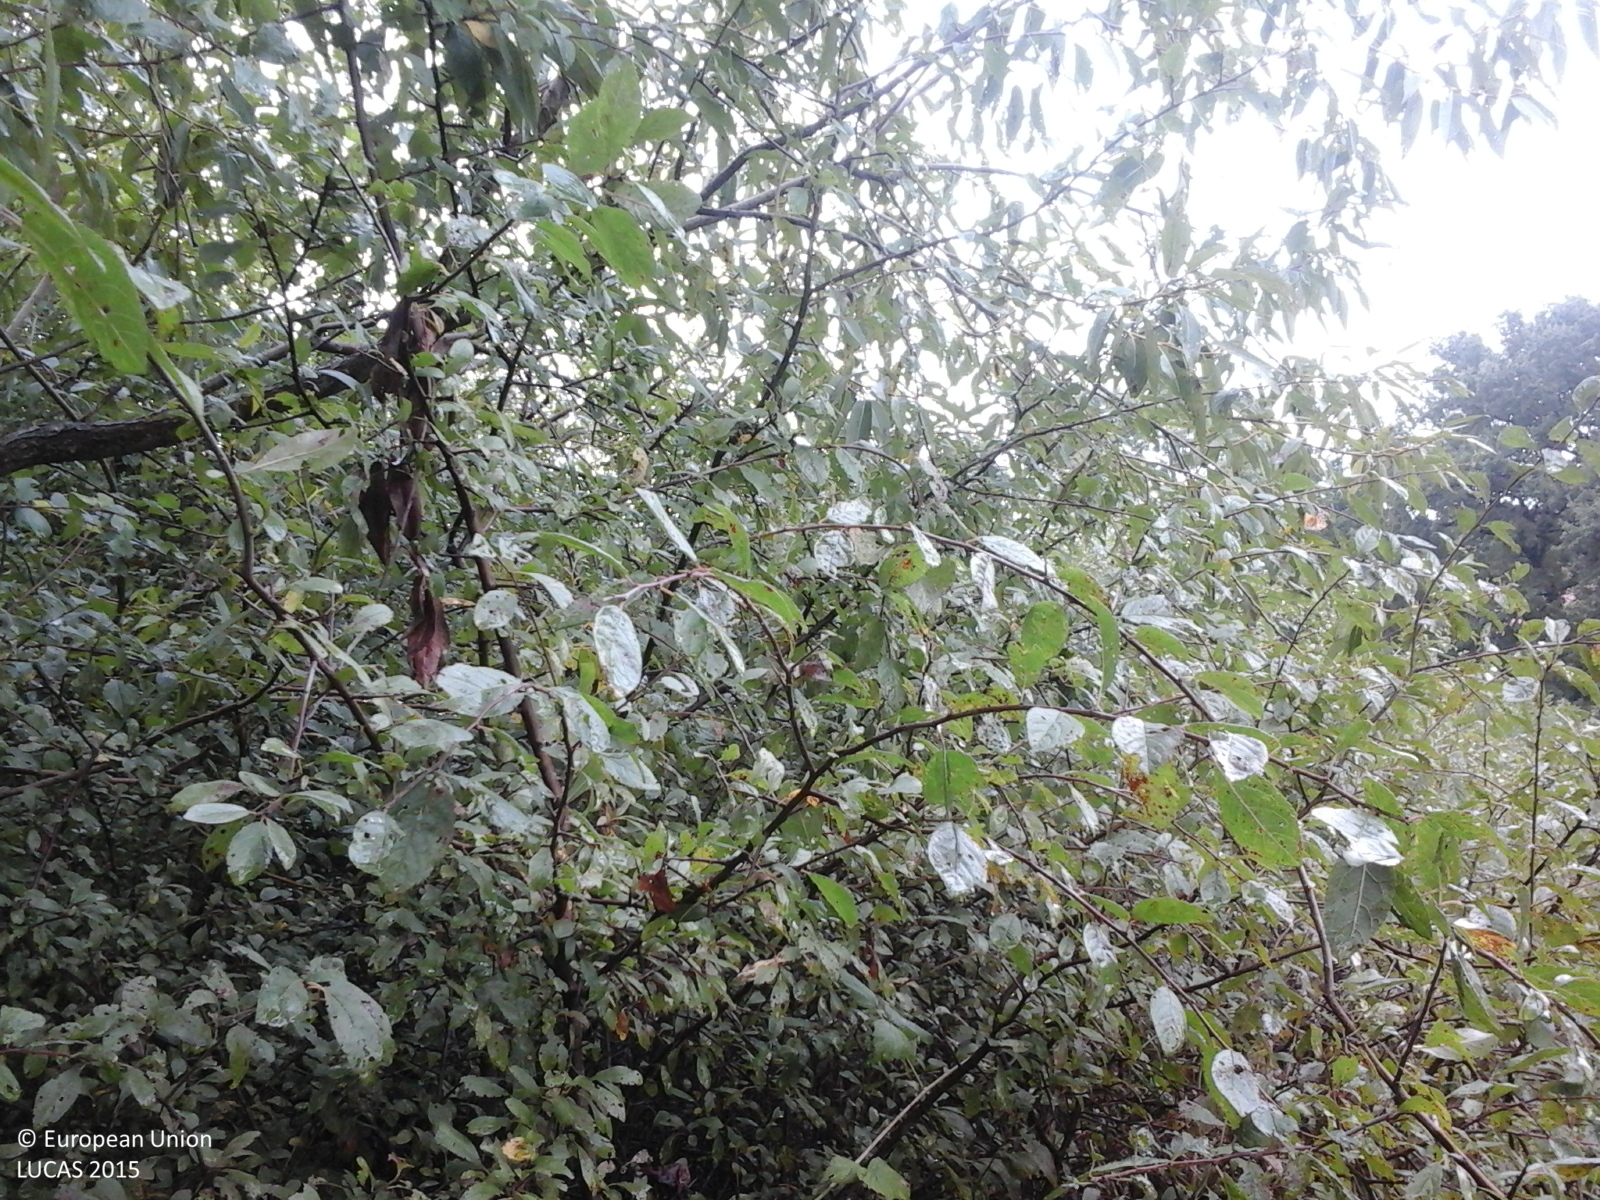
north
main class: Woodland
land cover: Broadleaved woodland
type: non-riverine alder, birch or aspen forest
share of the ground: > 75 %
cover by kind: broadleaved forest trees 100 %
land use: Forestry
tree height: > 5 m
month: September
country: RO
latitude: 46.9657
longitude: 21.9935
